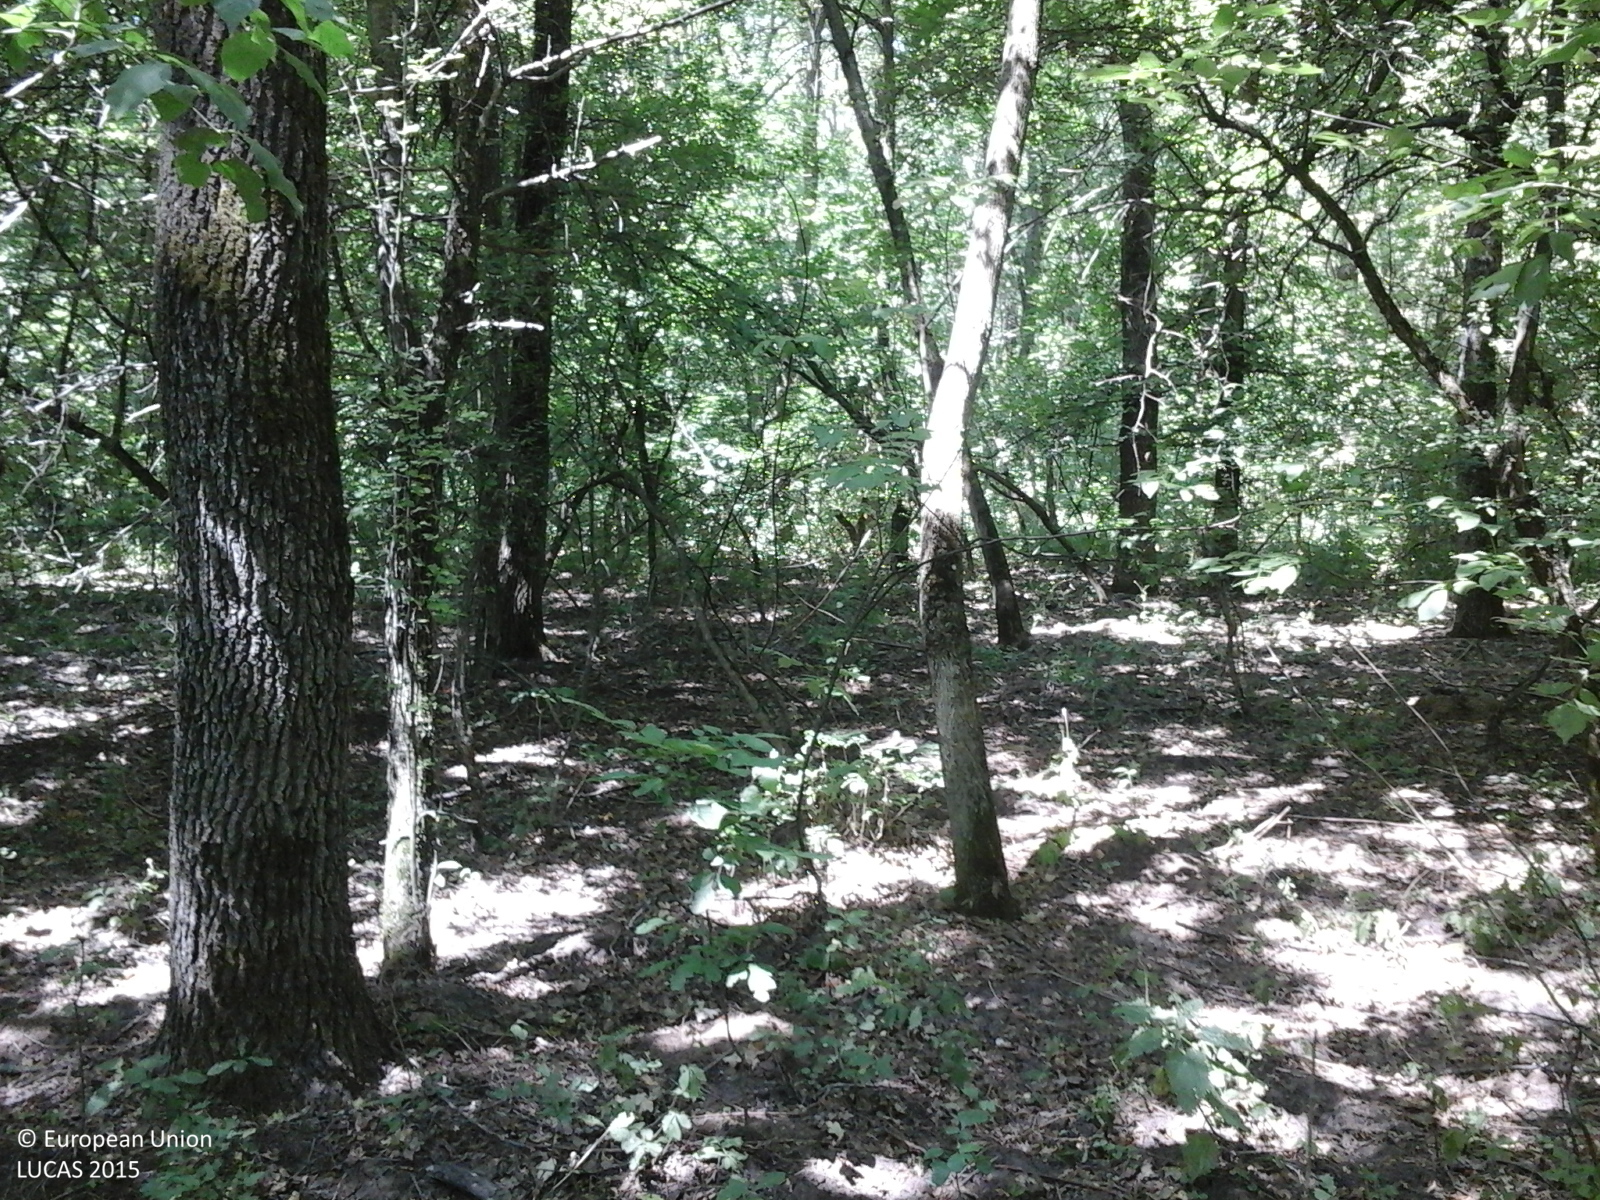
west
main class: Woodland
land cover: Broadleaved woodland
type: acidophilous oak and oak-birch forest
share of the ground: > 75 %
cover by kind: broadleaved forest trees 100 %
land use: Forestry
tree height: > 5 m
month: July
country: RO
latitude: 44.4130
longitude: 26.4004
